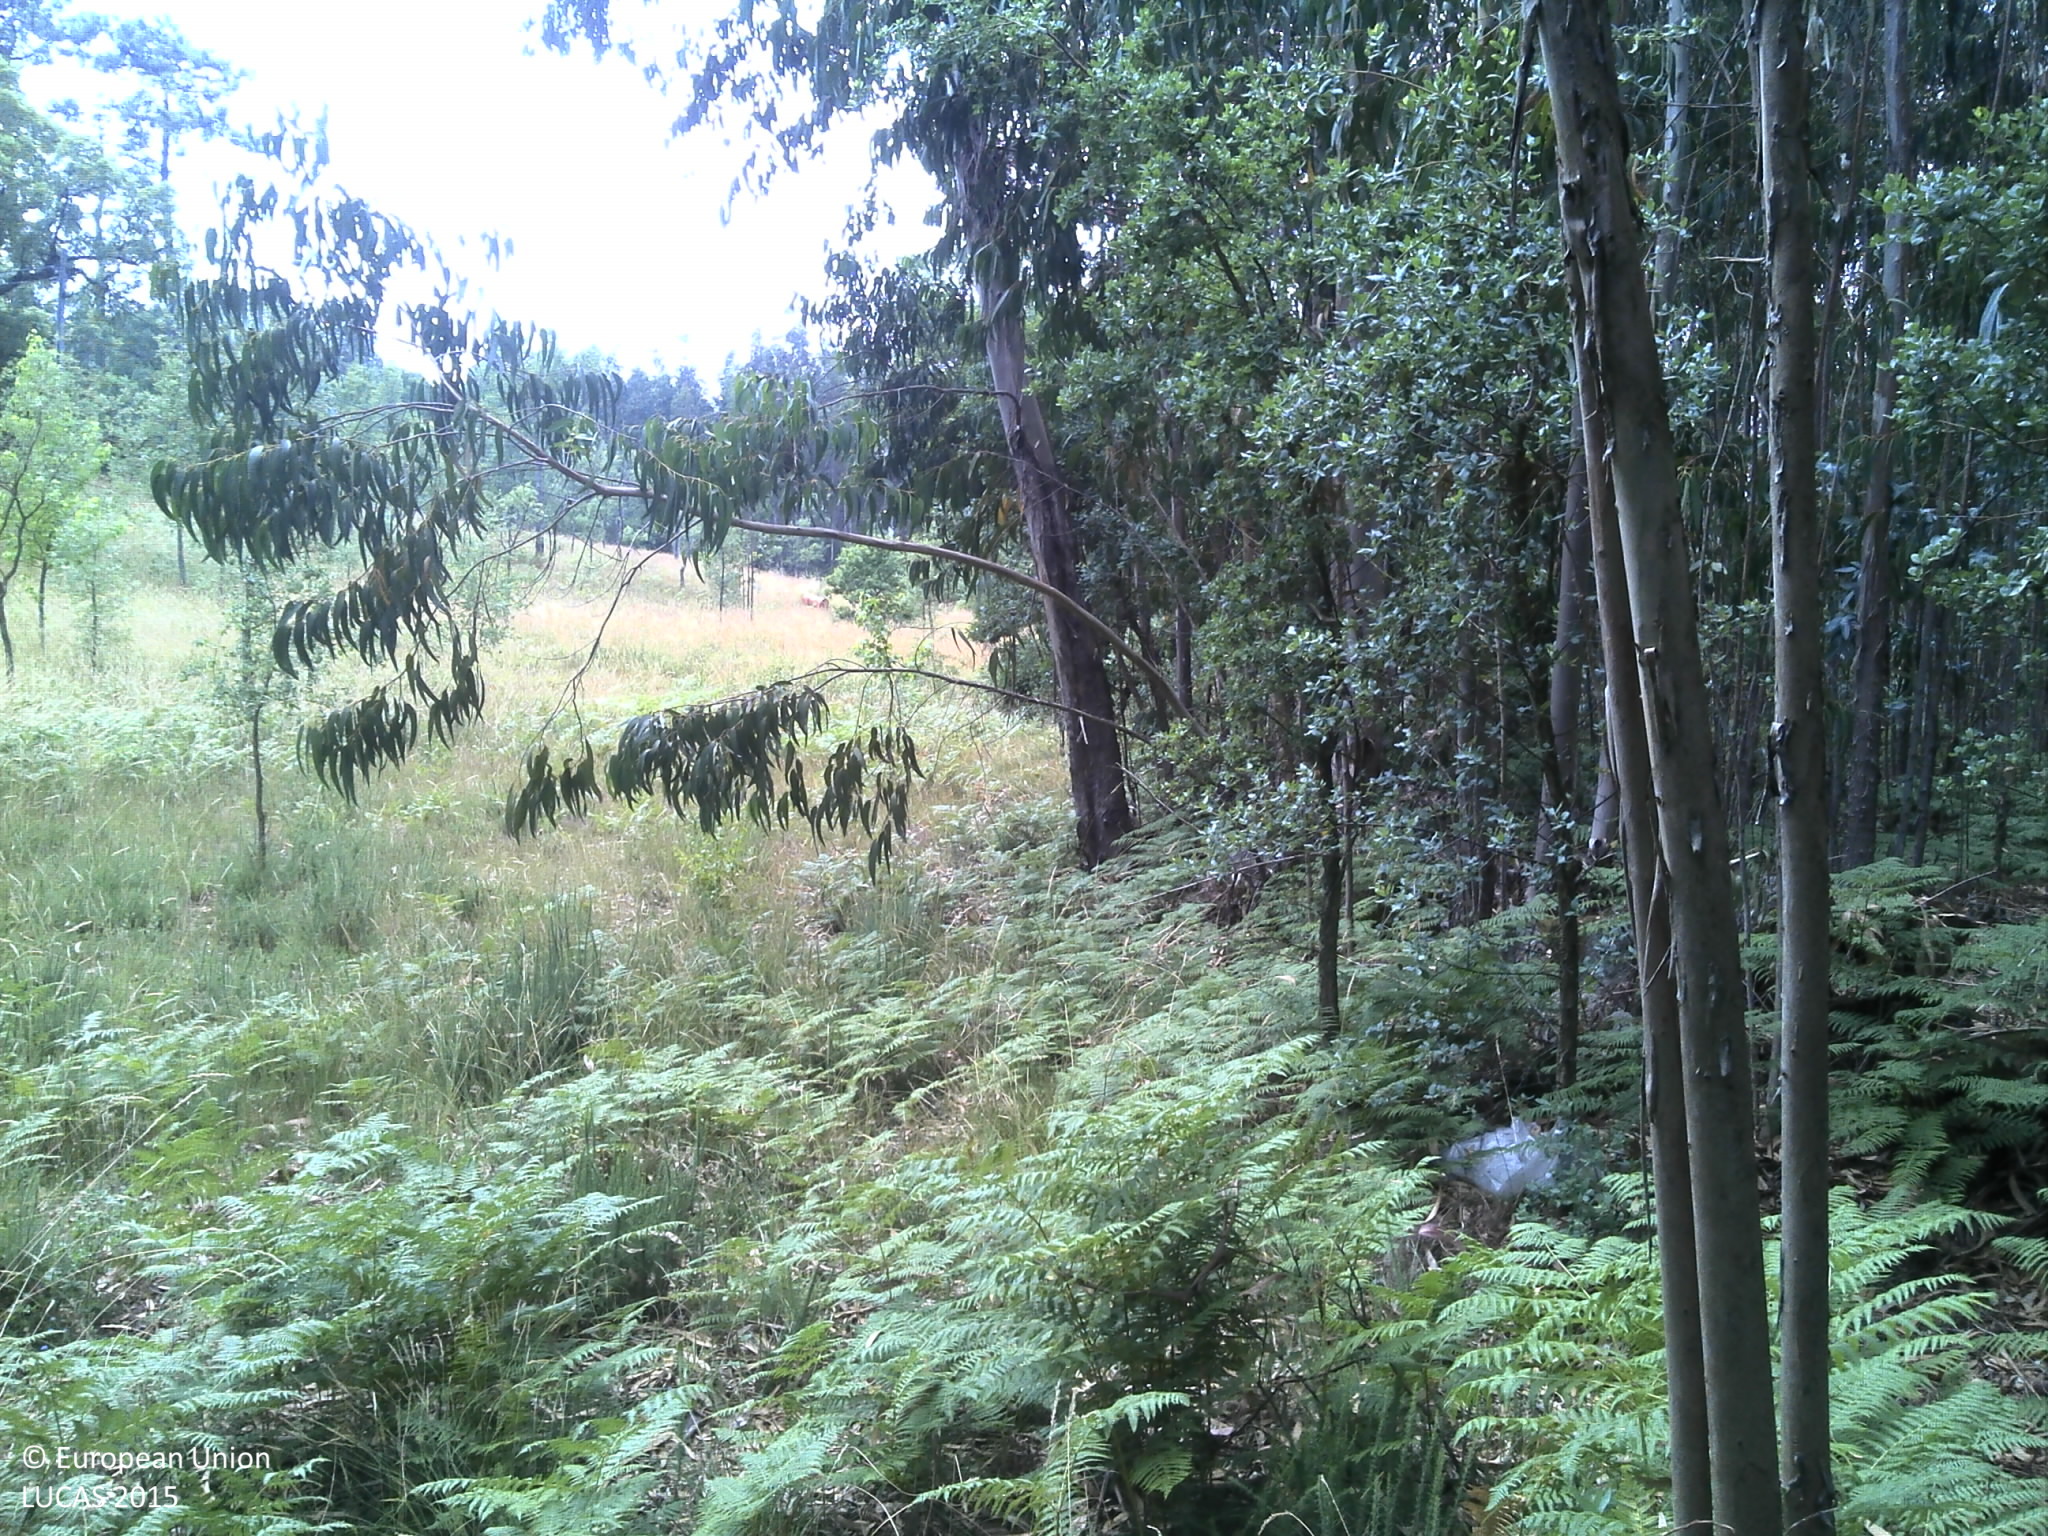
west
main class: Woodland
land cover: Broadleaved woodland
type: exotic forest
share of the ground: 50 - 75 %
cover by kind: broadleaved forest trees 65 %, shrubs 20 %, unconsolidated bare surface 15 %
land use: Forestry
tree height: > 5 m
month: June
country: PT
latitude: 40.7057
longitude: -8.3286
